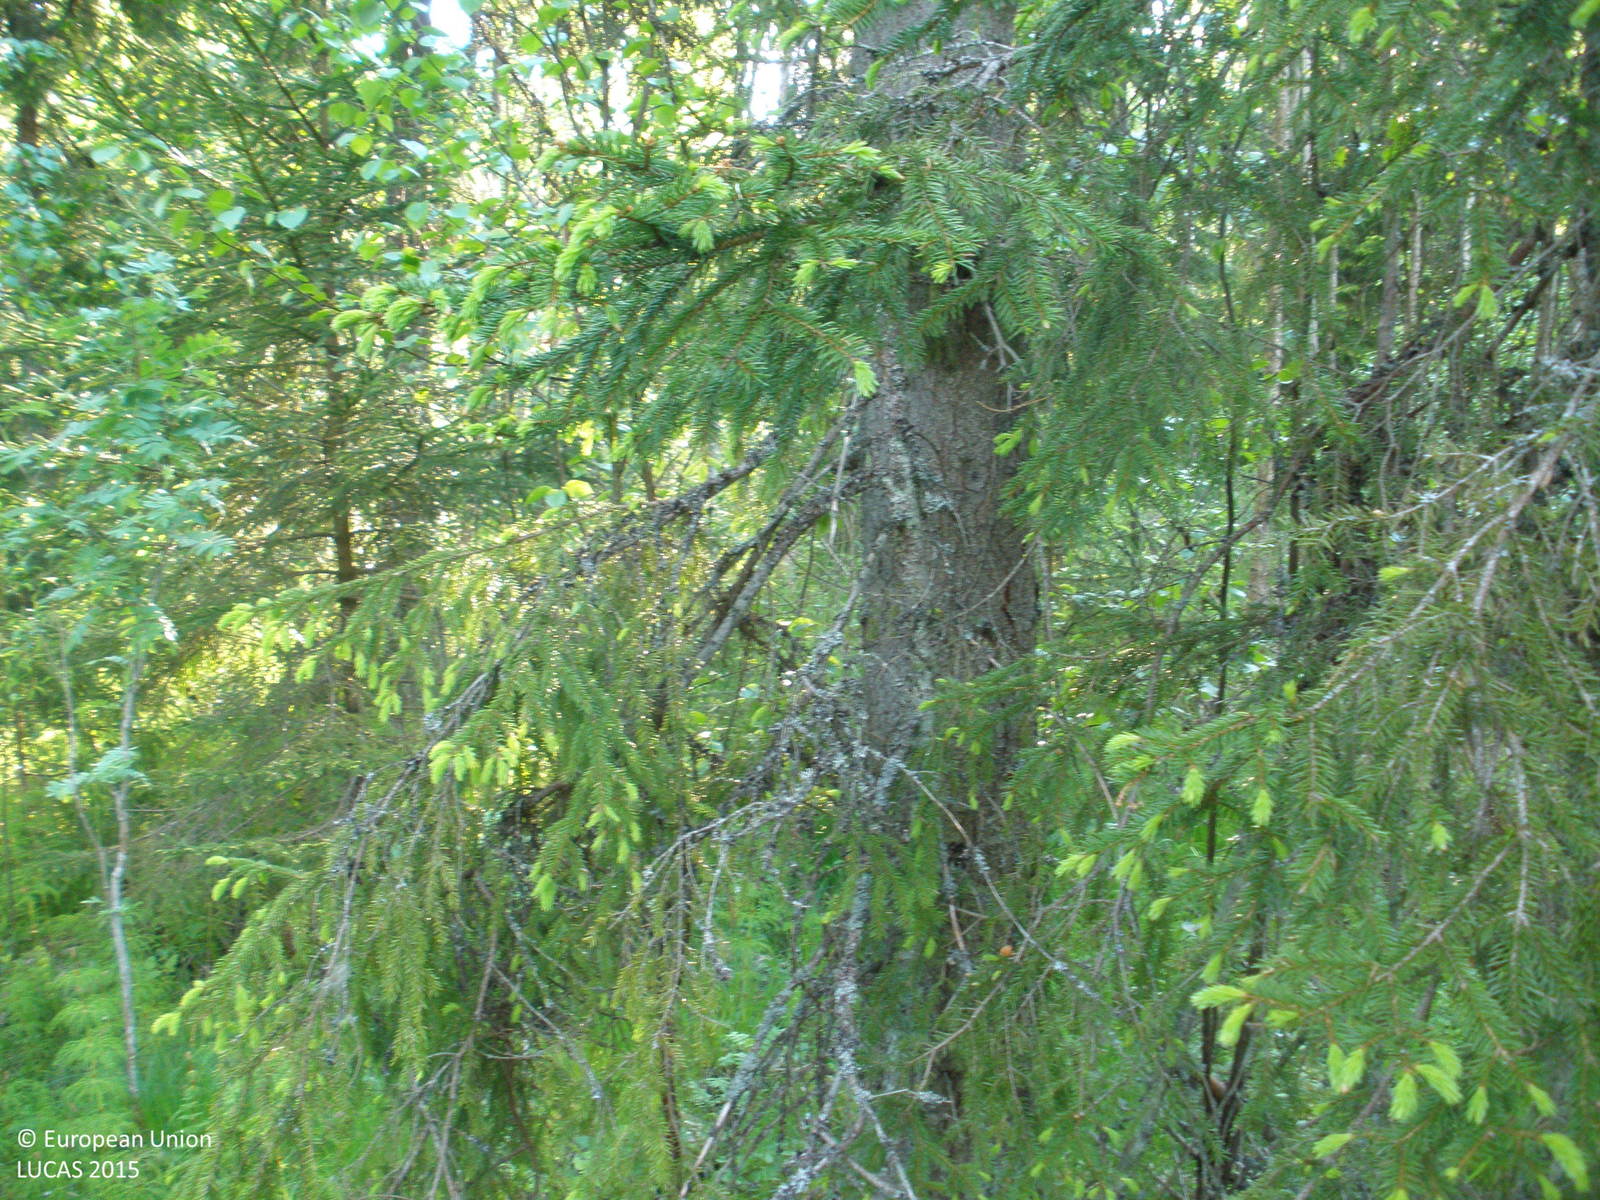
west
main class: Woodland
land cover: Spruce dominated mixed woodland
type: boreal forest
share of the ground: 50 - 75 %
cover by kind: coniferous forest trees 45 %, broadleaved forest trees 25 %, herbaceous plants 15 %, shrubs 10 %, lichens and mosses 5 %
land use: Forestry
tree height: > 5 m
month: June
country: FI
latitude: 60.8886
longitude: 23.6297
